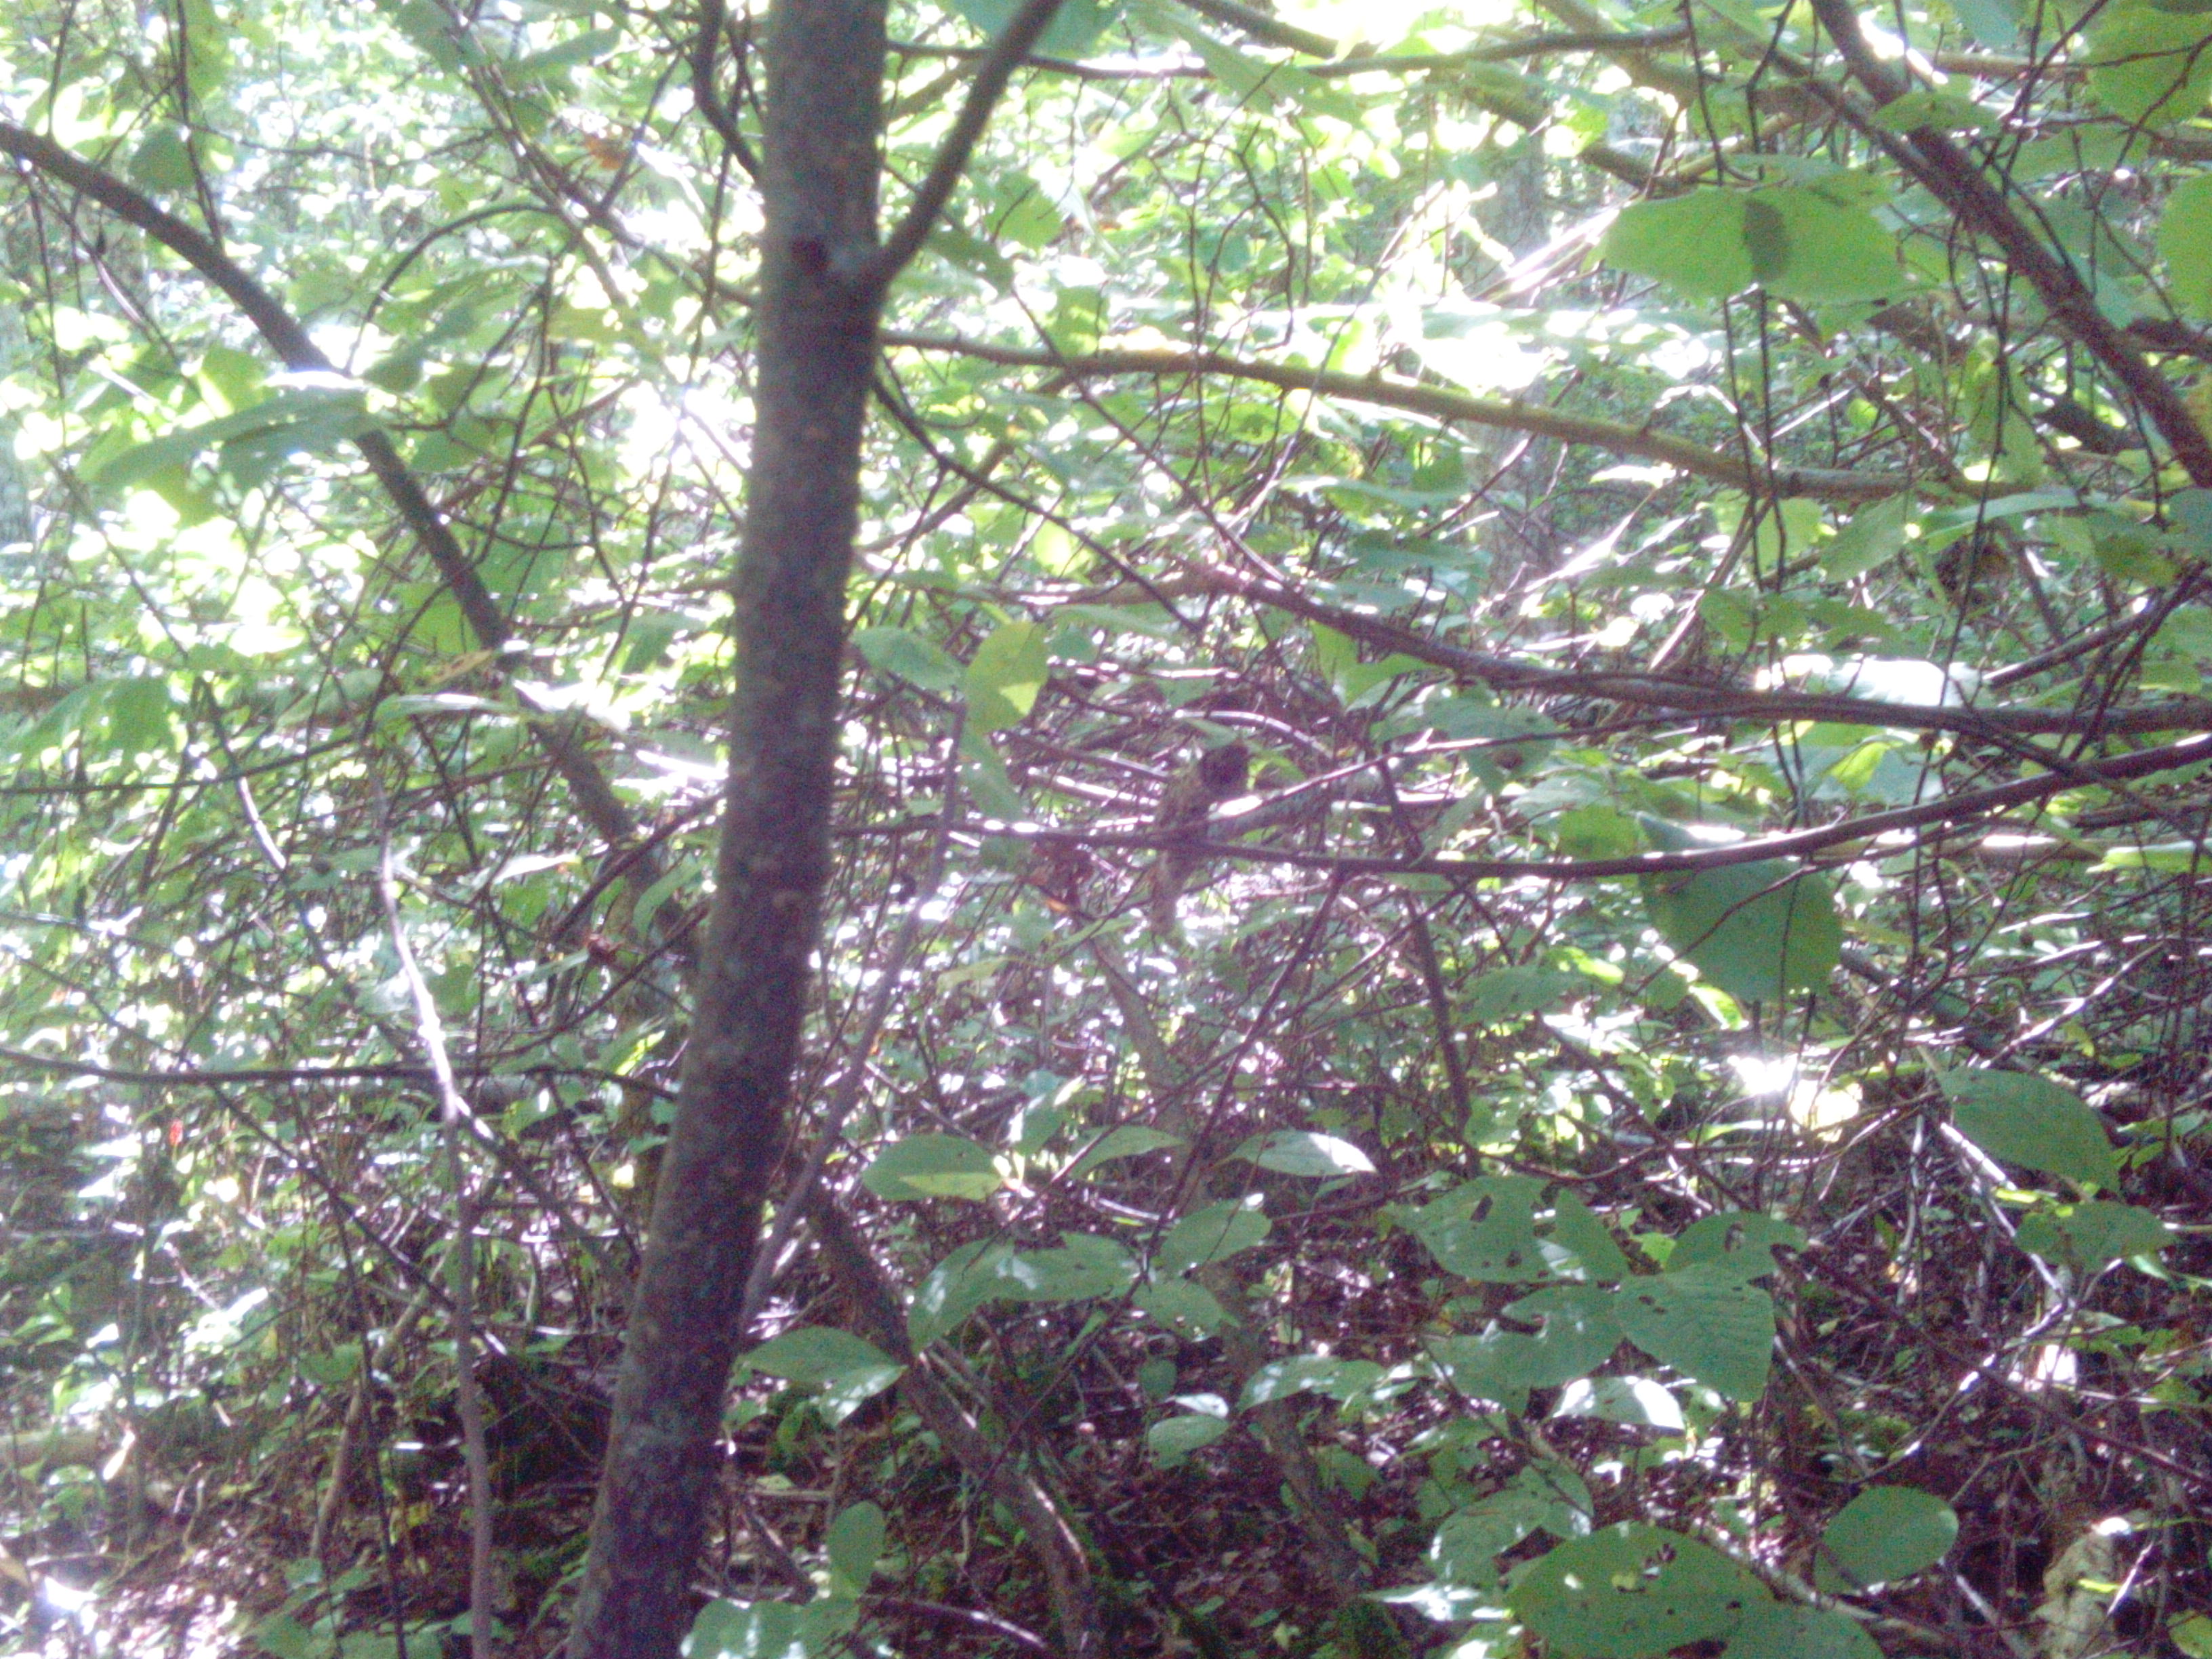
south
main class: Woodland
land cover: Broadleaved woodland
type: non-riverine alder, birch or aspen forest
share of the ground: > 75 %
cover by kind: broadleaved forest trees 95 %, herbaceous plants 5 %
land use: Forestry
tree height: > 5 m
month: August
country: LV
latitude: 56.4992
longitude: 21.3632
